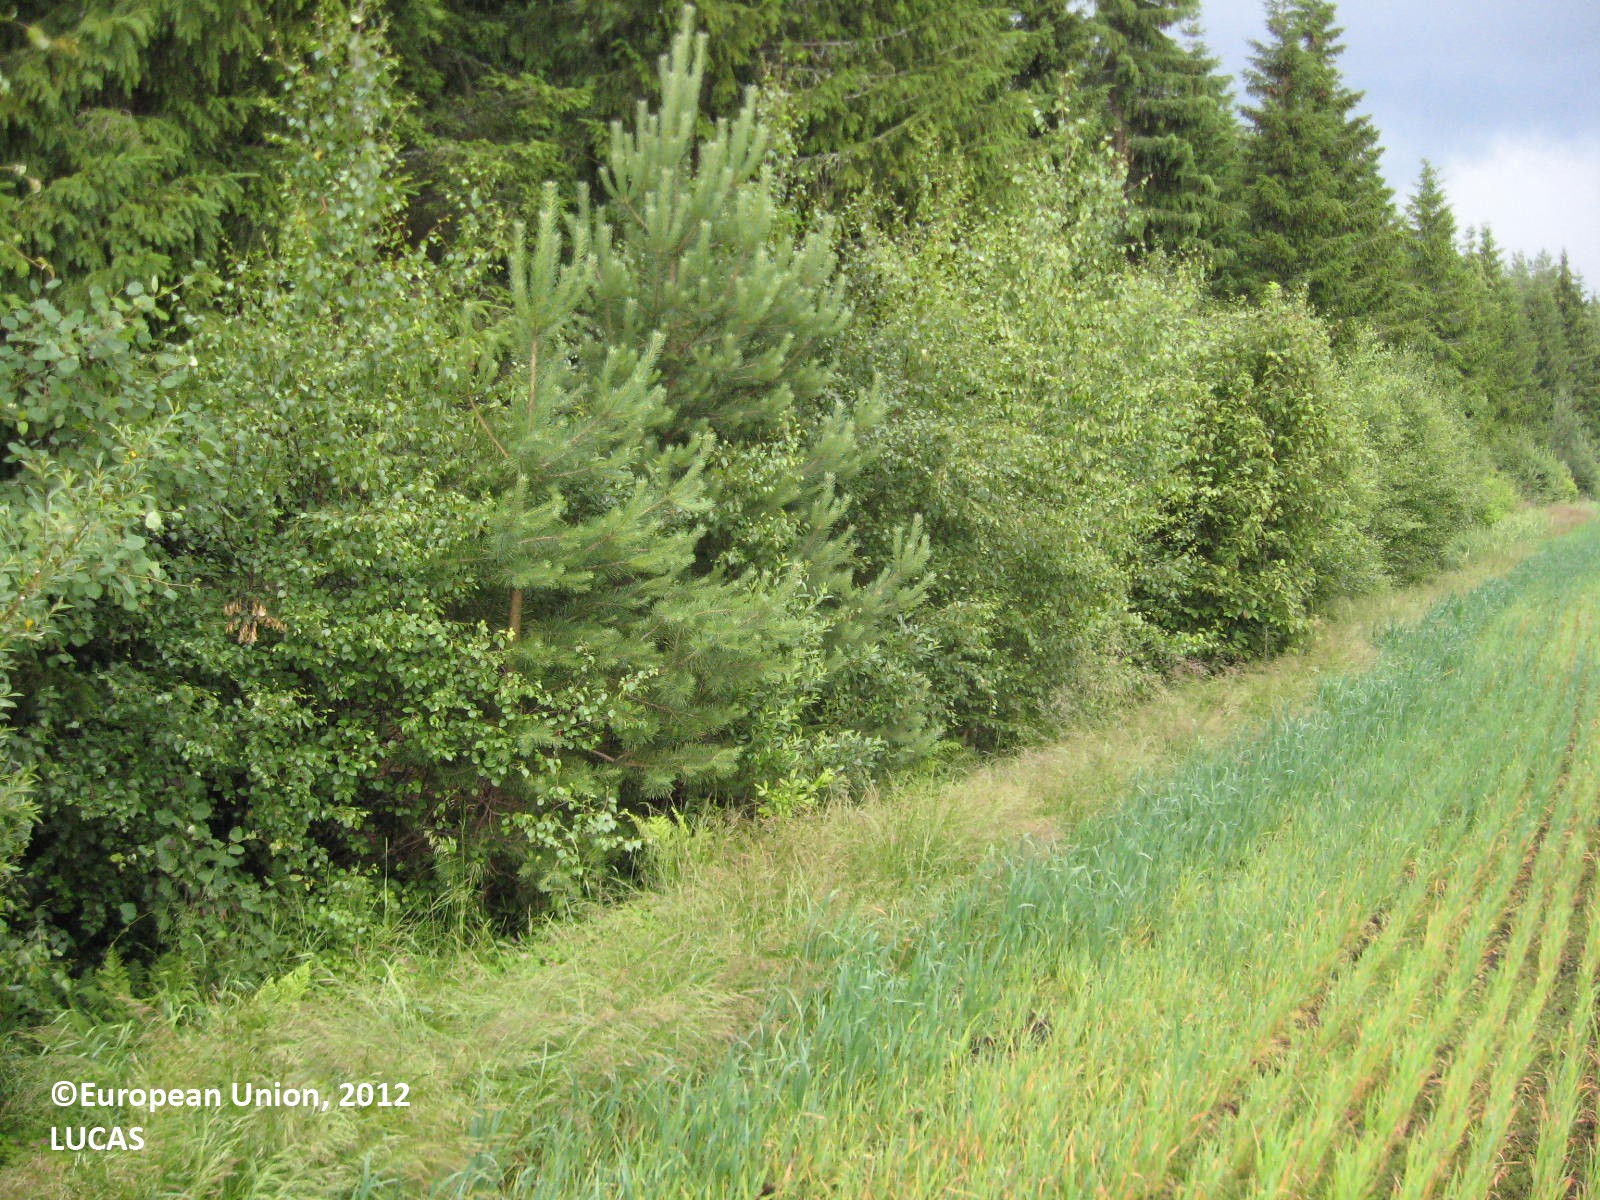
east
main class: Cropland
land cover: Oats
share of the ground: > 75 %
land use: Agriculture (excluding fallow land and kitchen gardens)
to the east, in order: Oats; Shruby margins; Ditches and canals; Spruce dominated coniferous woodland; Pine dominated coniferous woodland; Ditches and canals; Shruby margins; Grass margins; Paved roads, cycling and walking lanes; Grass margins; Shruby margins; Ditches and canals; Pine dominated coniferous woodland
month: July
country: FI
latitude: 62.3811
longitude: 22.7247
